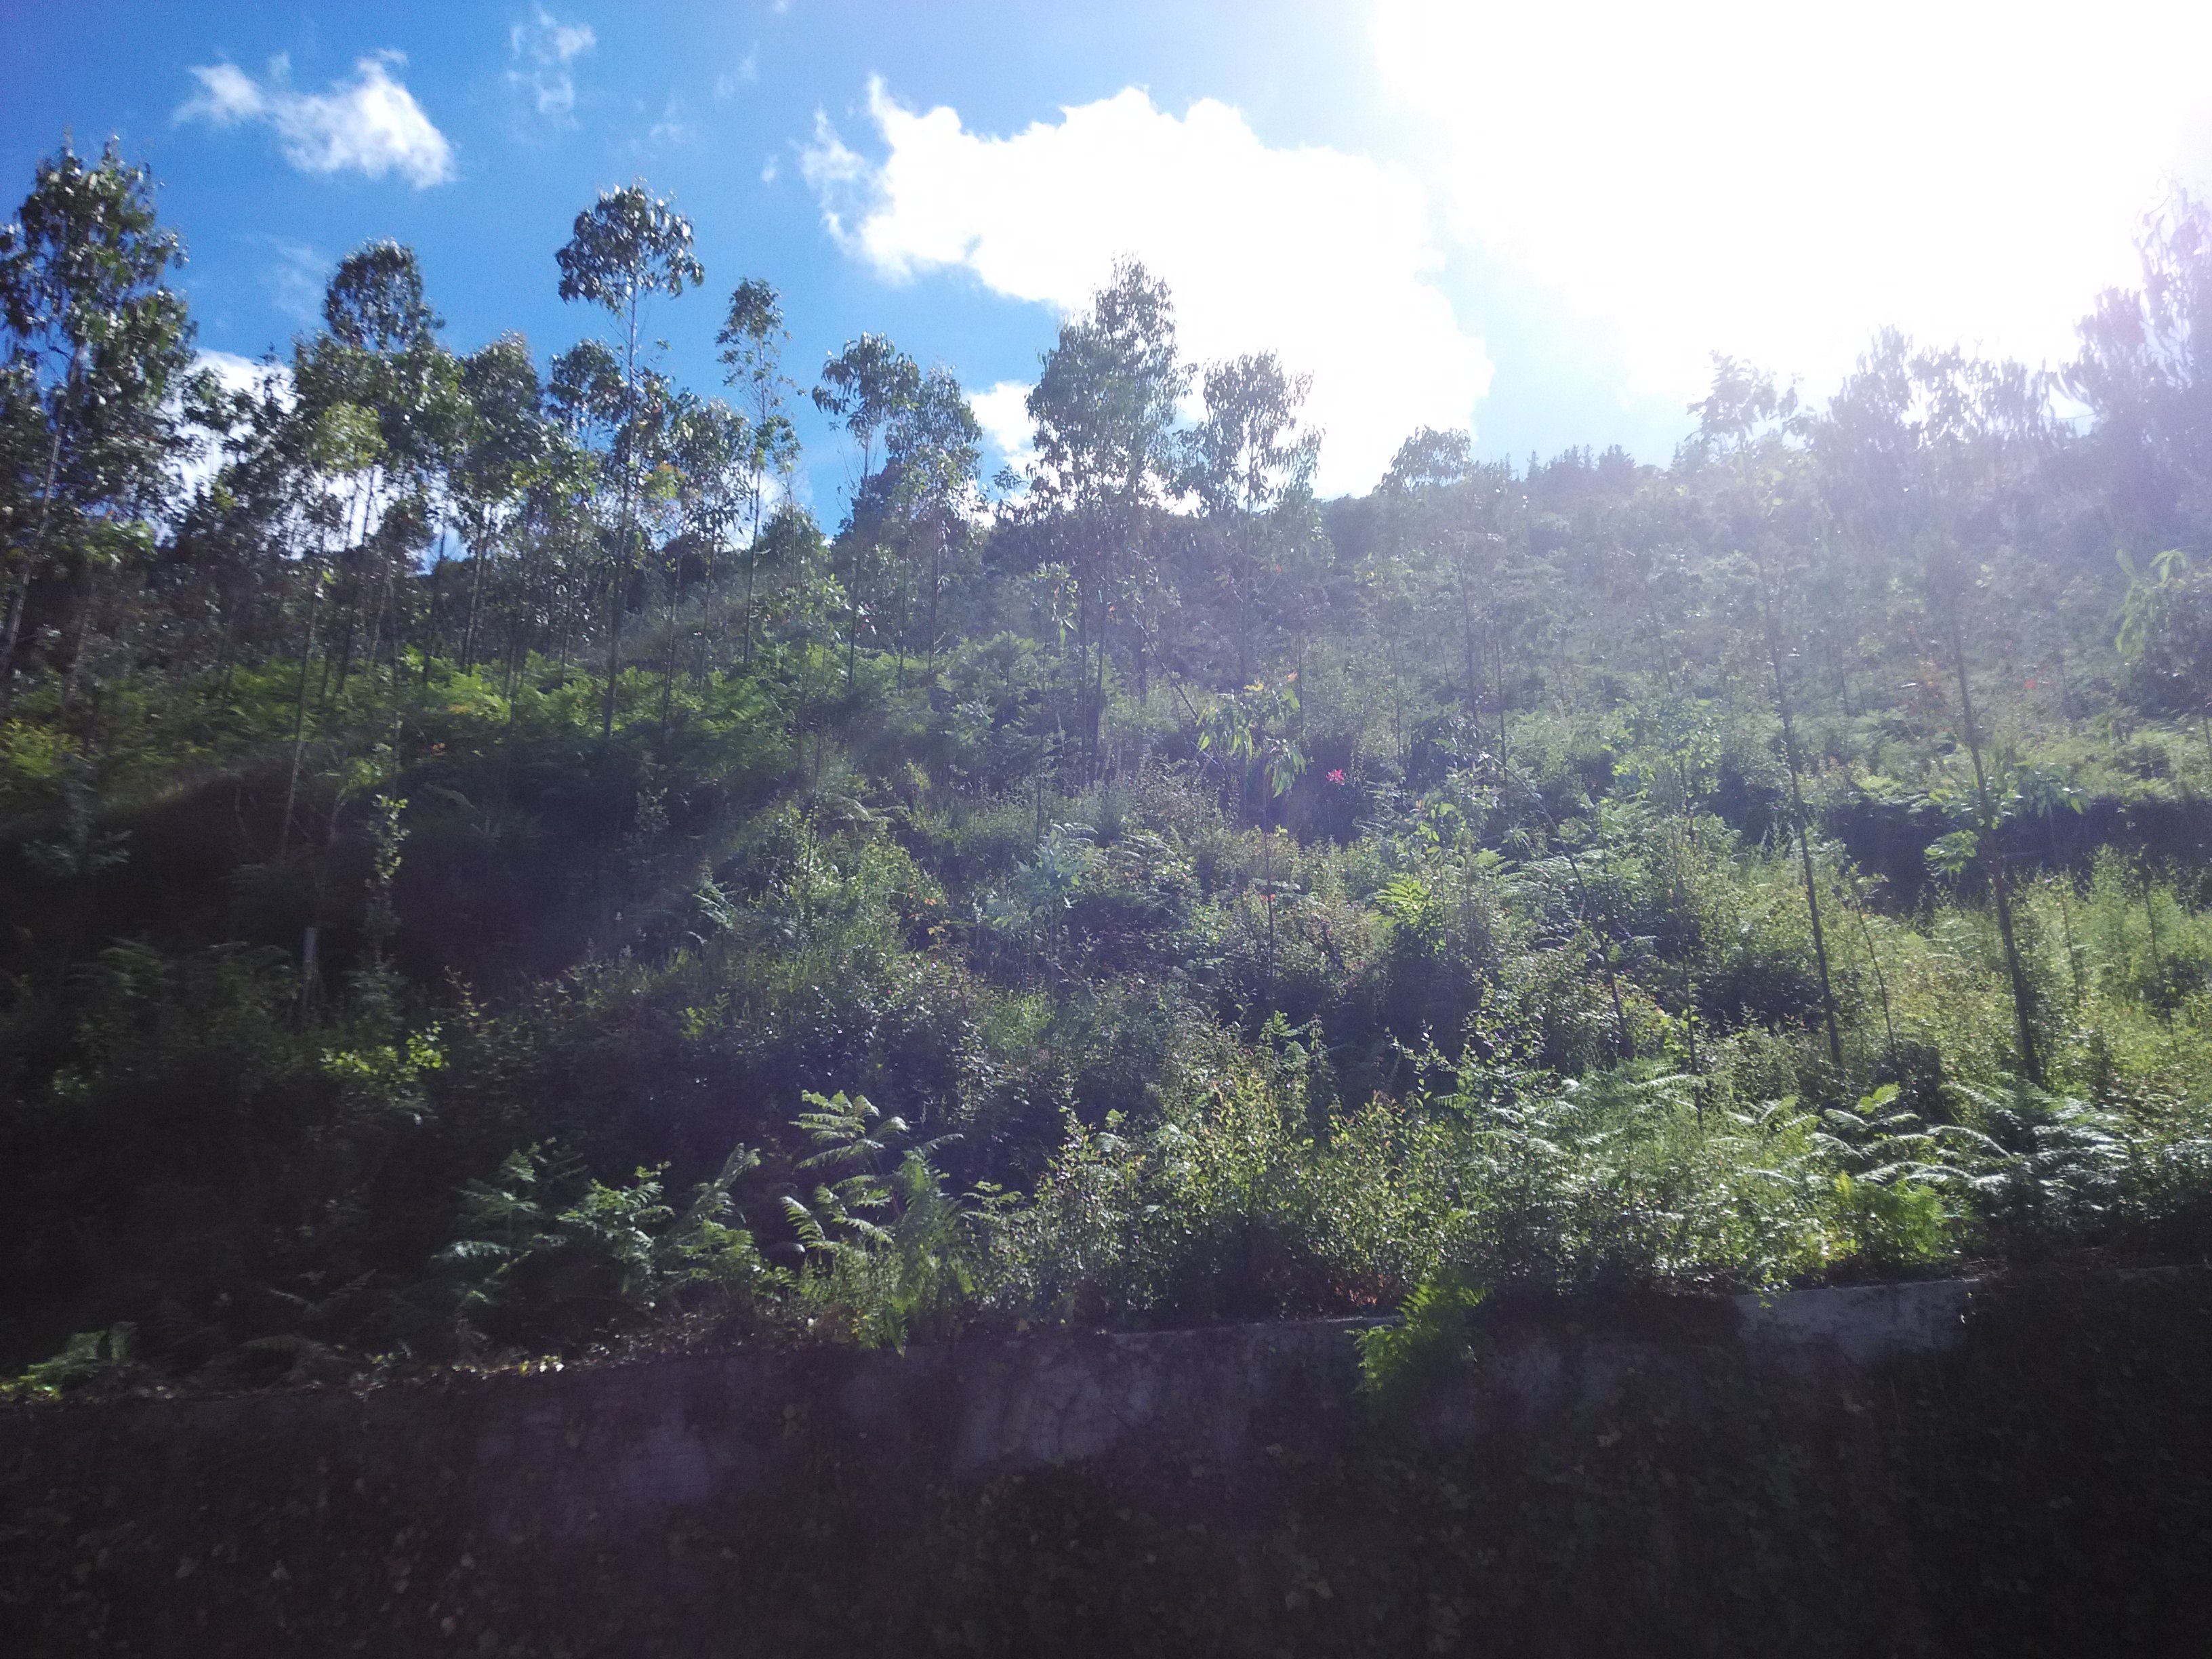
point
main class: Woodland
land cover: Broadleaved woodland
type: exotic forest
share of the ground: > 75 %
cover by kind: broadleaved forest trees 100 %
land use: Forestry
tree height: < 5 m
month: June
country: ES
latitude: 43.3303
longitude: -2.5475
